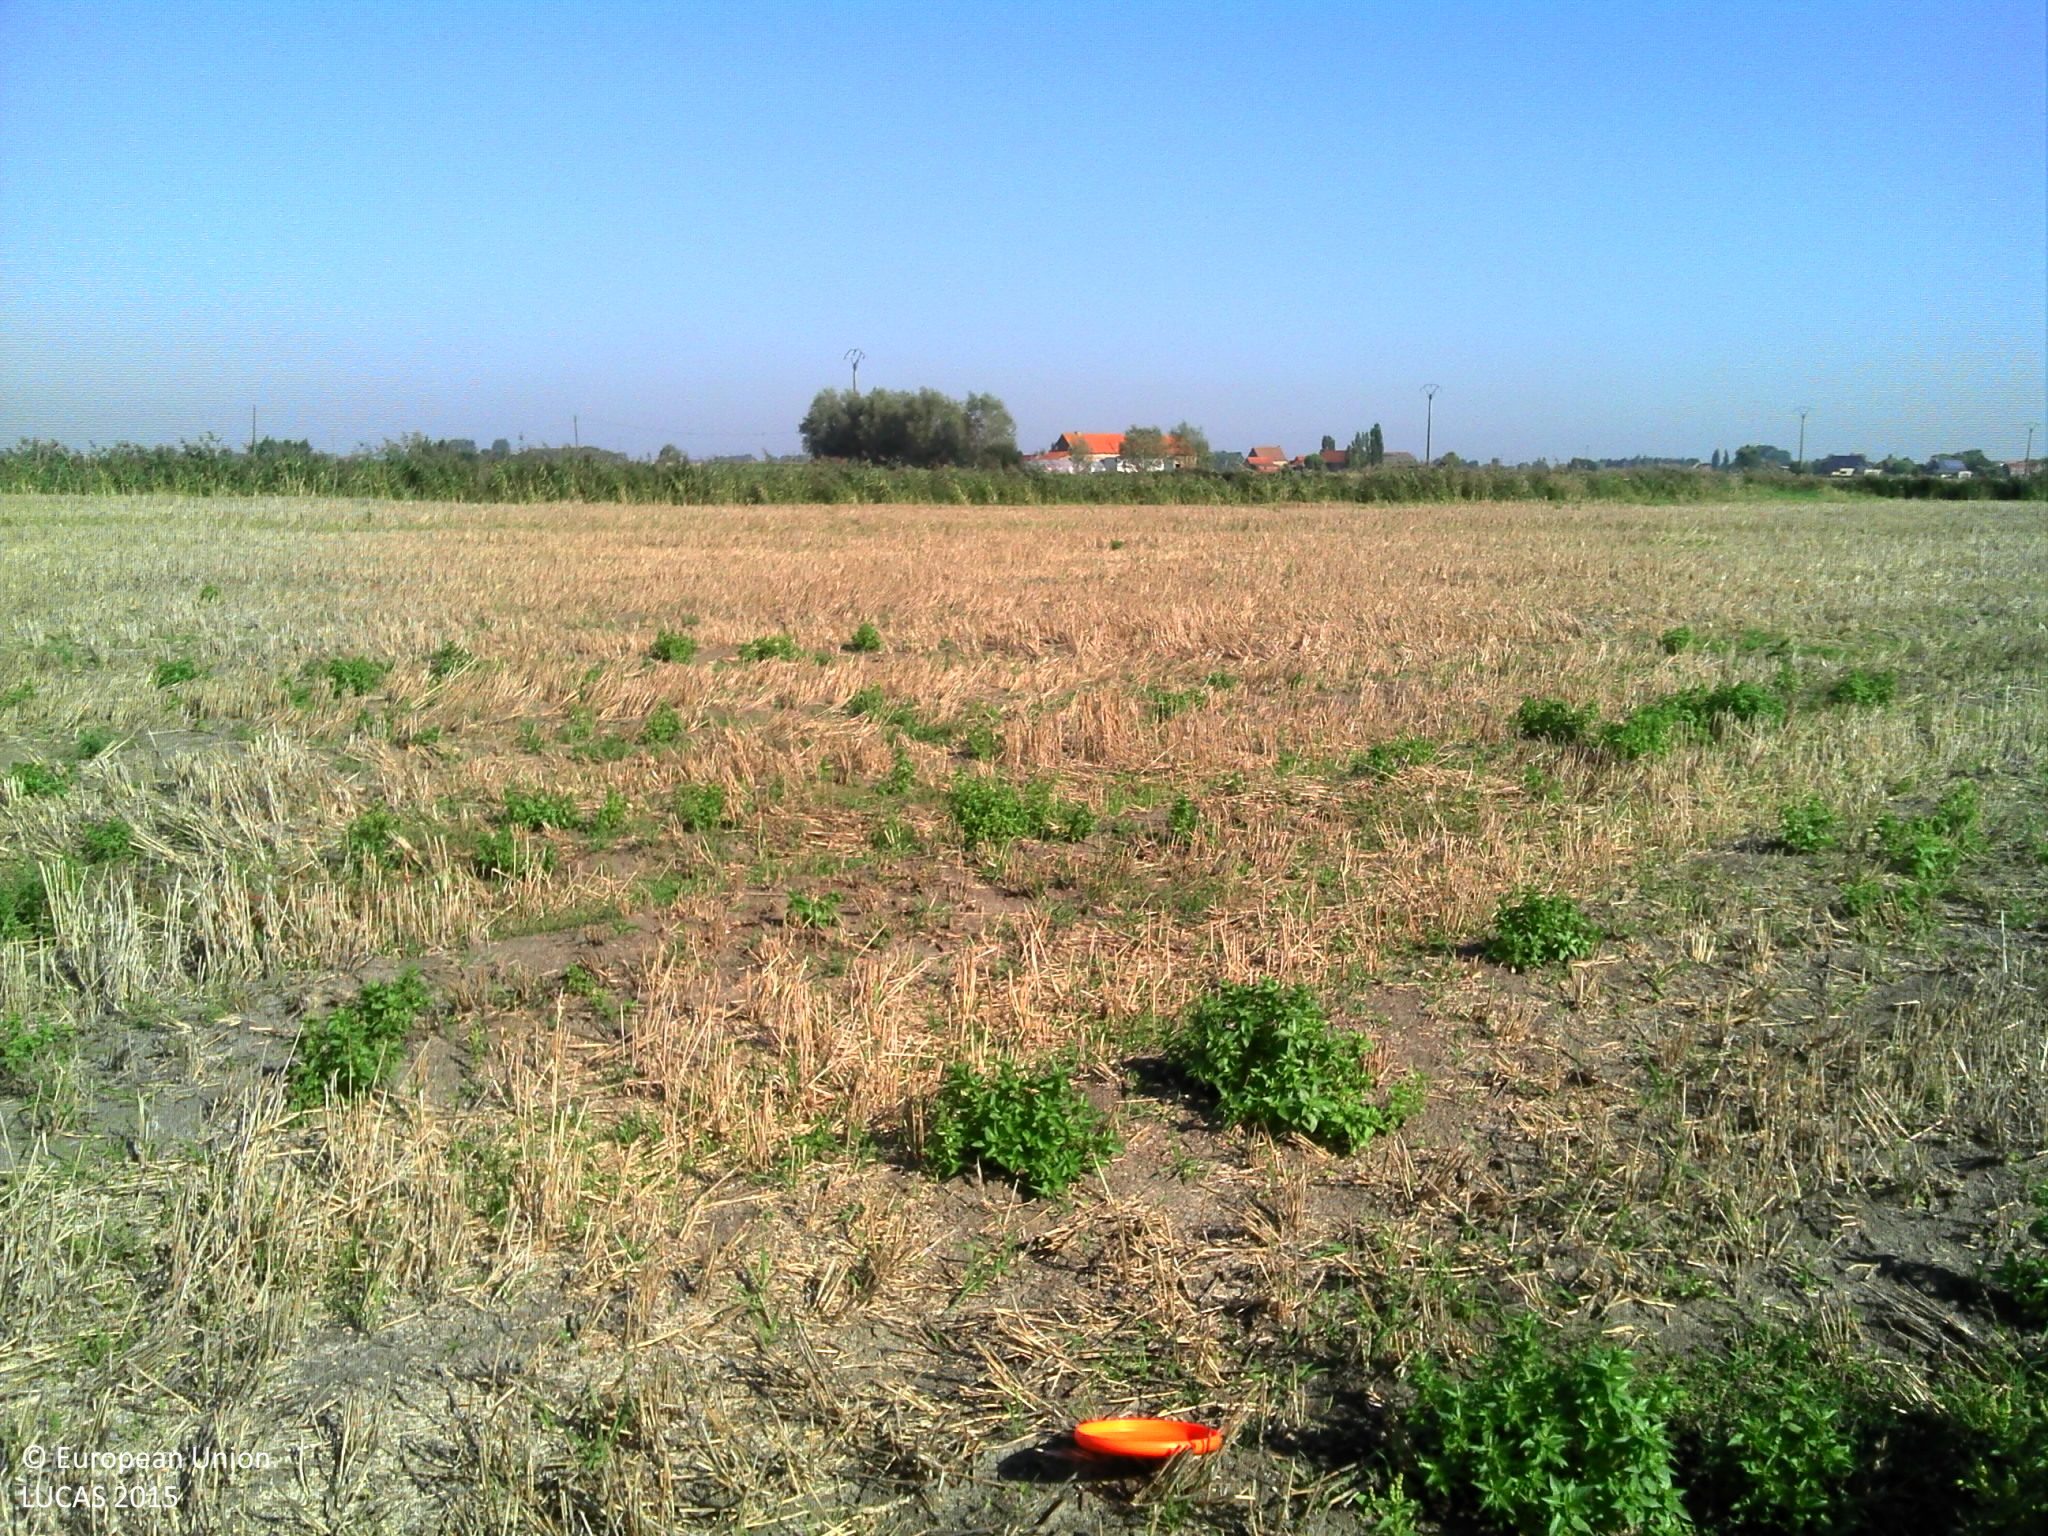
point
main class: Cropland
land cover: Common wheat
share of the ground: 25 - 50 %
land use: Agriculture (excluding fallow land and kitchen gardens)
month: September
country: BE
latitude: 51.0388
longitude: 2.7866
